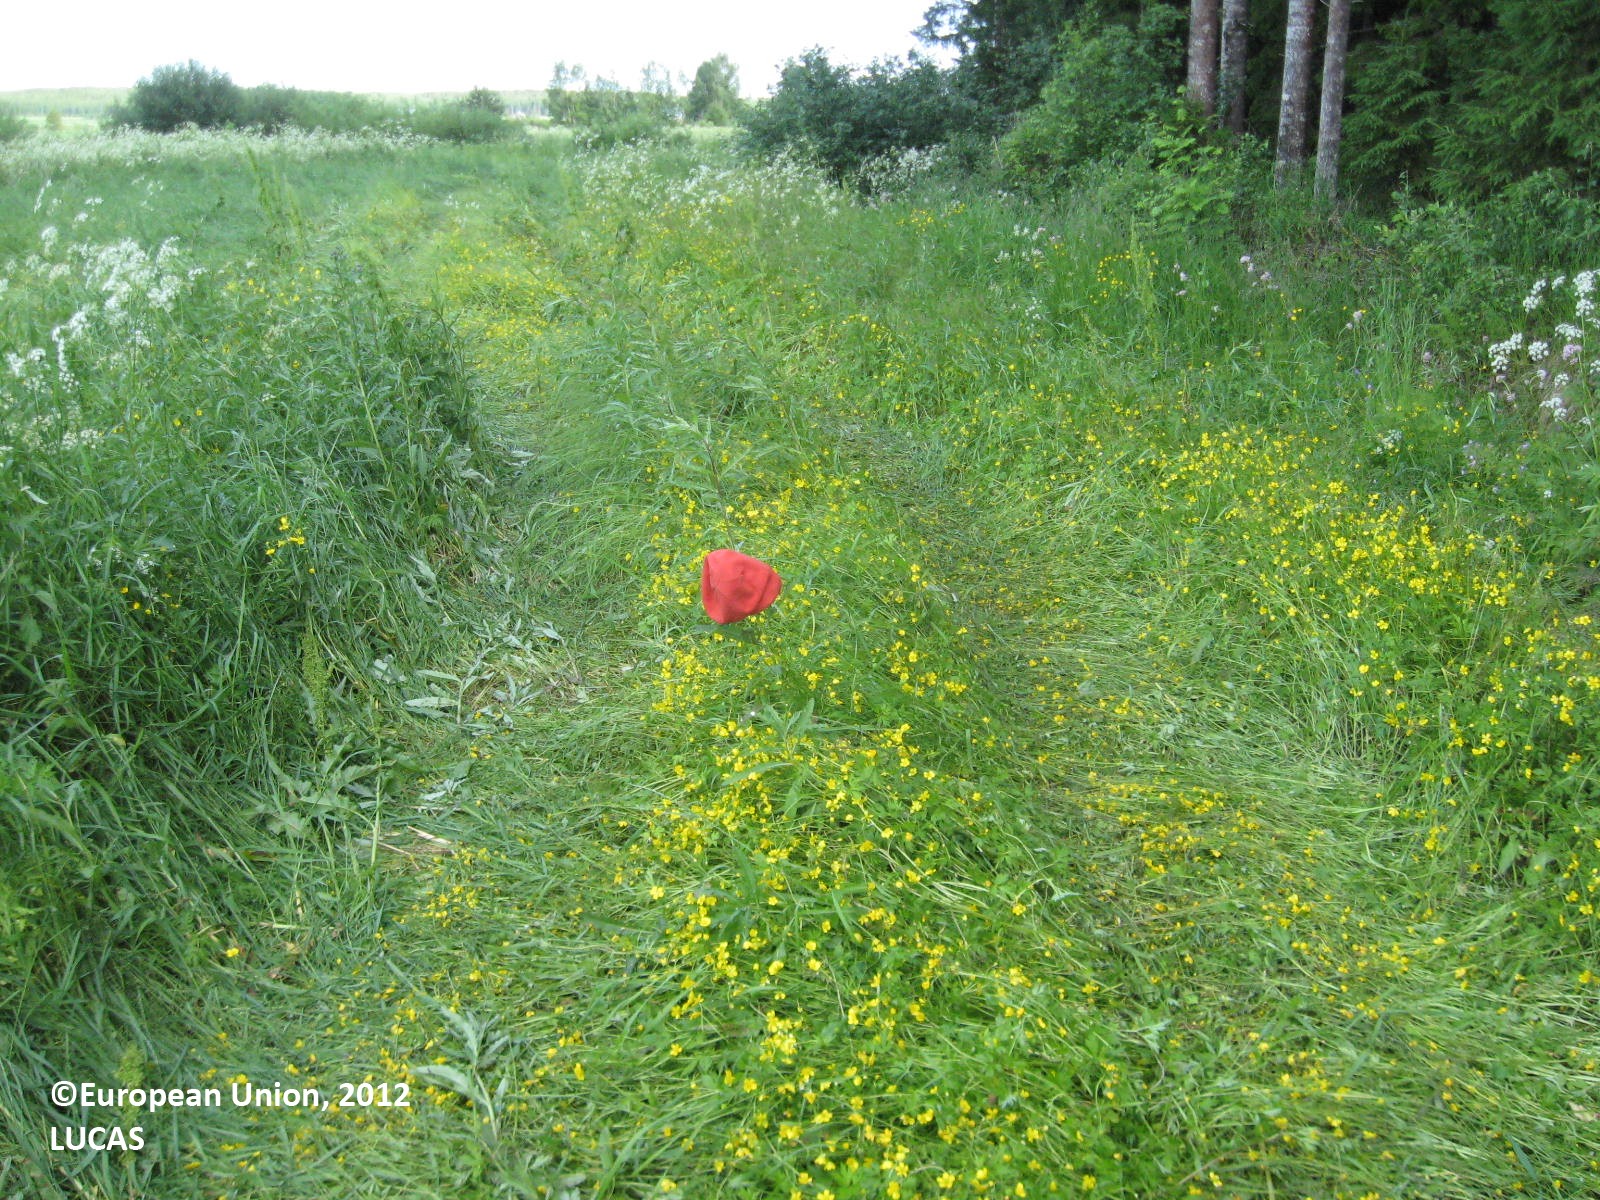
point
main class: Grassland
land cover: Grassland without tree/shrub cover
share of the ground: > 75 %
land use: Agriculture (excluding fallow land and kitchen gardens)
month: July
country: FI
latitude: 62.5499
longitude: 22.6776
